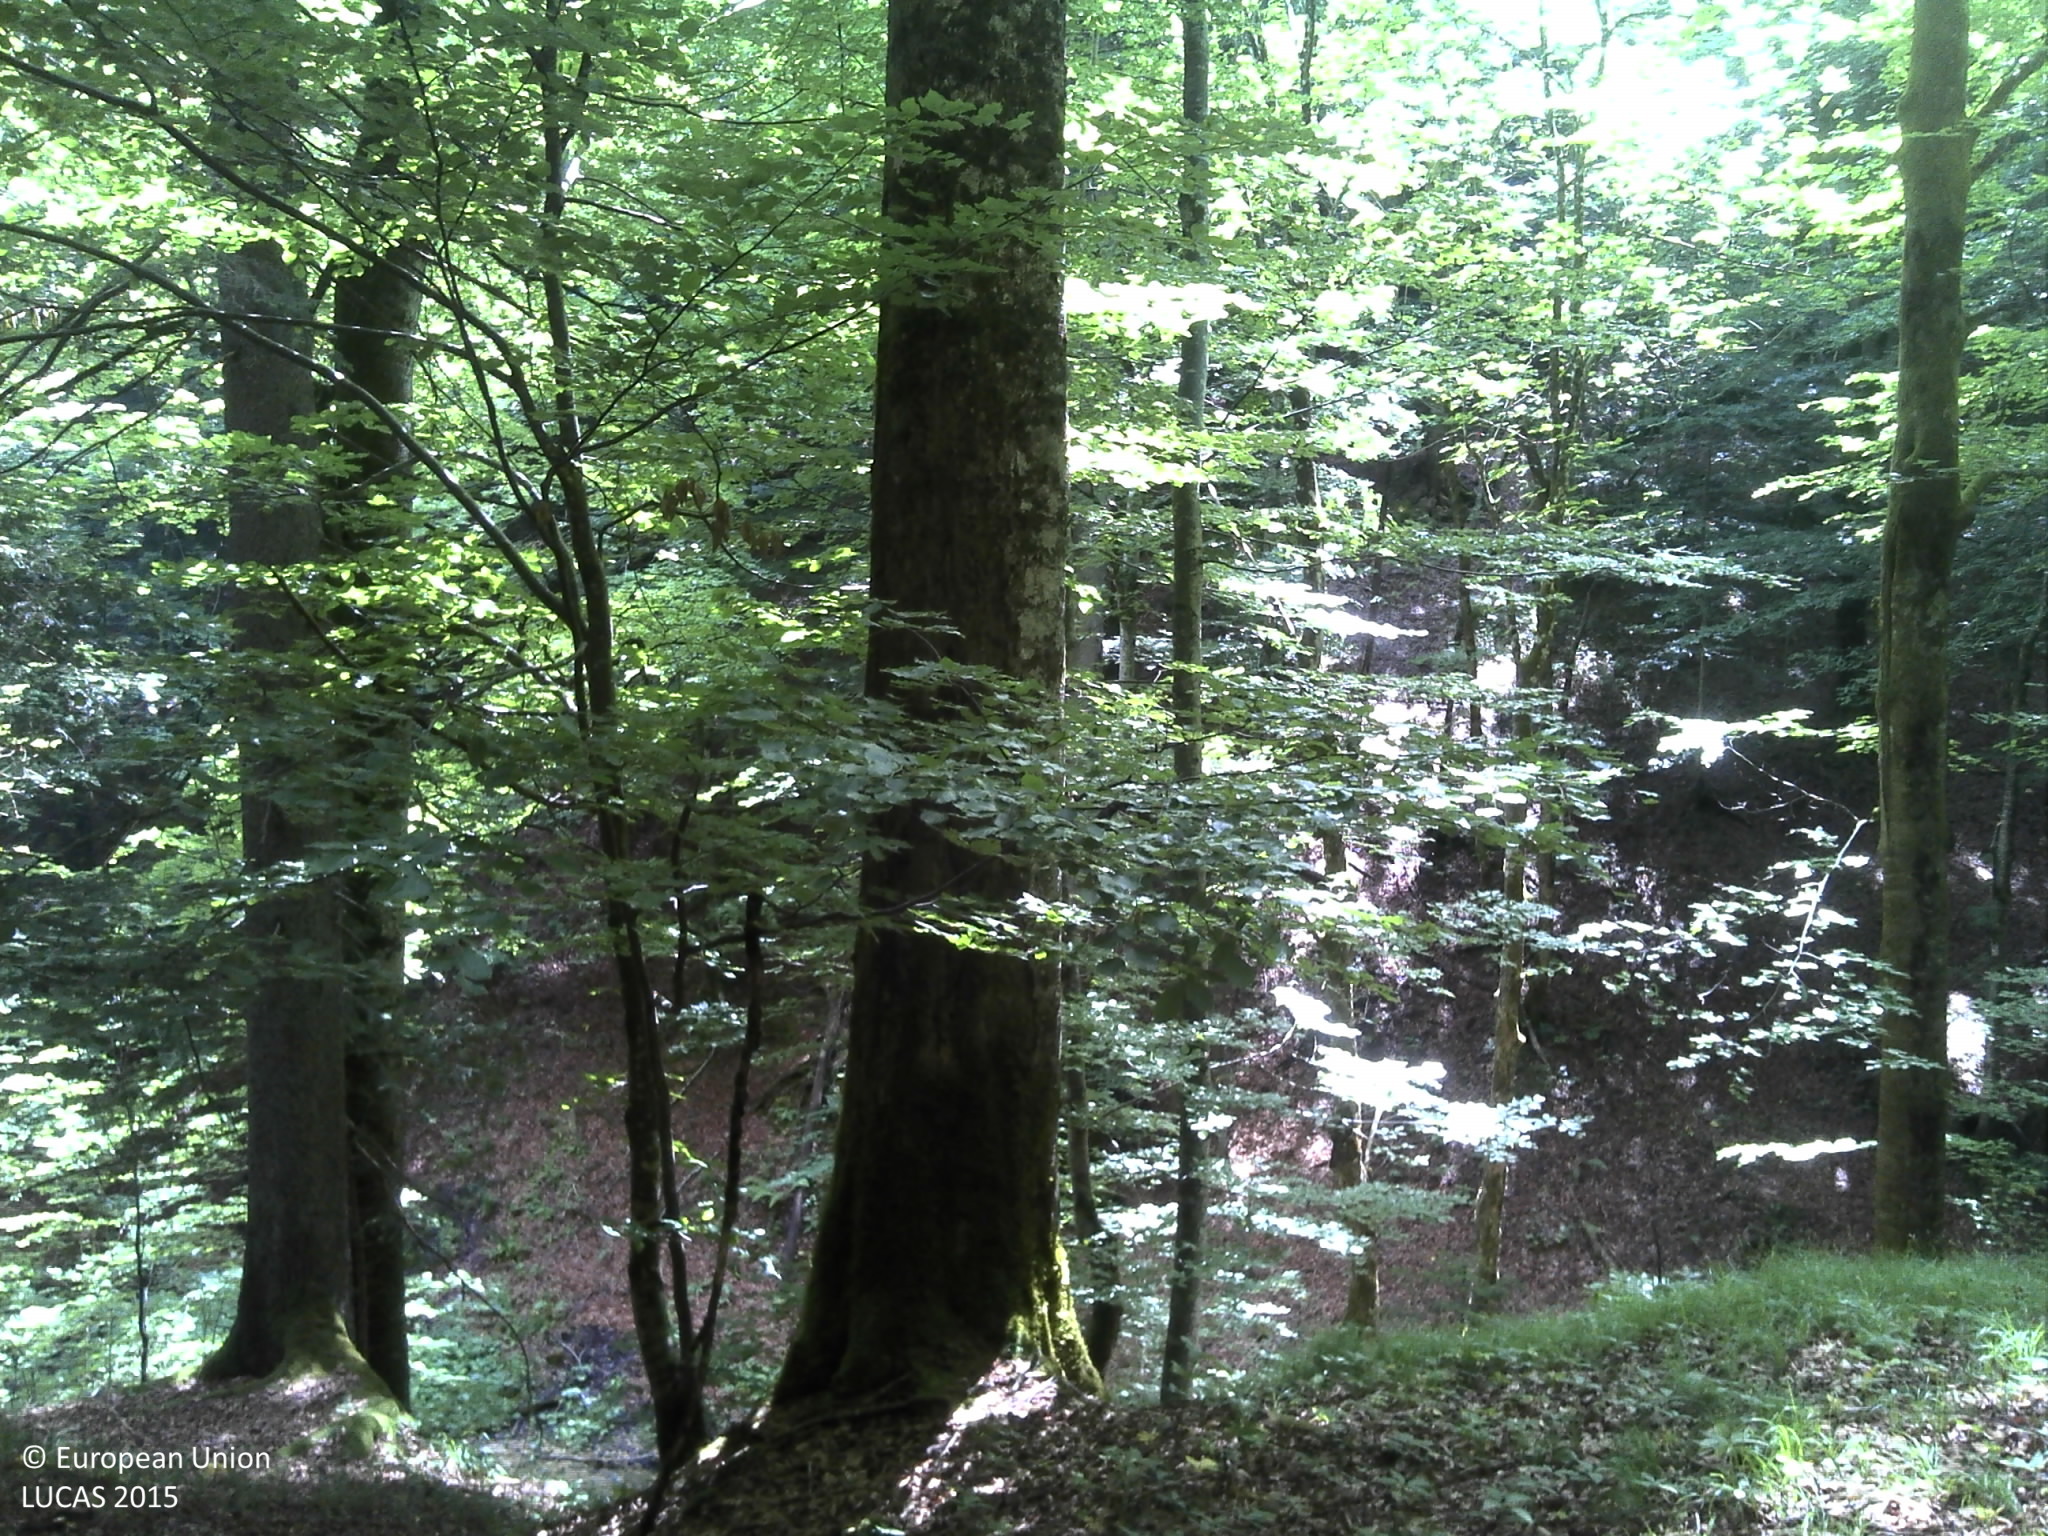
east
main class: Woodland
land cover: Broadleaved woodland
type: beech forest
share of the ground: > 75 %
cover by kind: broadleaved forest trees 95 %, consolidated bare surface 5 %
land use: Semi-natural and natural areas not in use
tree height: > 5 m
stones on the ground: < 10 %
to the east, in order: Broadleaved woodland; Inland fresh running water; Broadleaved woodland
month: June
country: HR
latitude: 44.8486
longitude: 15.6249
